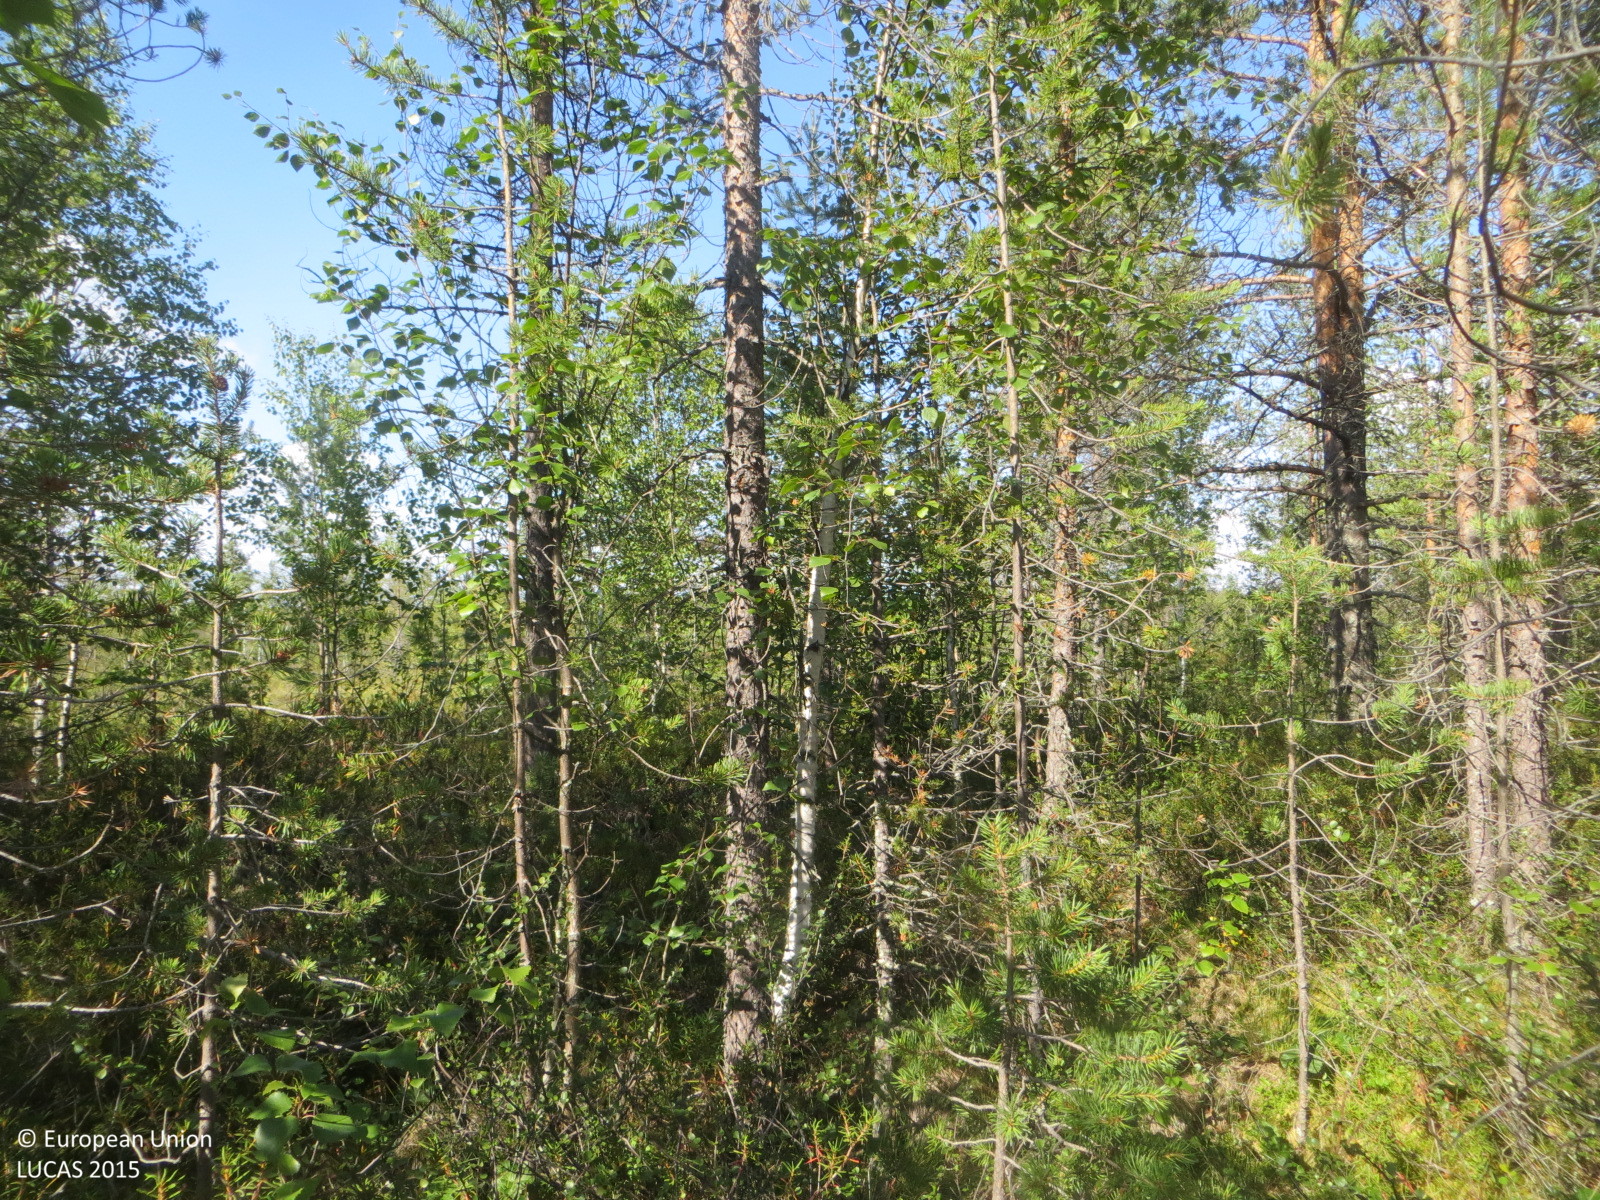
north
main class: Woodland
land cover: Pine dominated mixed woodland
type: mire and swamp forests
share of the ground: 50 - 75 %
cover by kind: coniferous forest trees 40 %, shrubs 40 %, broadleaved forest trees 20 %
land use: Forestry
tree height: > 5 m
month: July
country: FI
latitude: 66.0564
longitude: 24.0202
